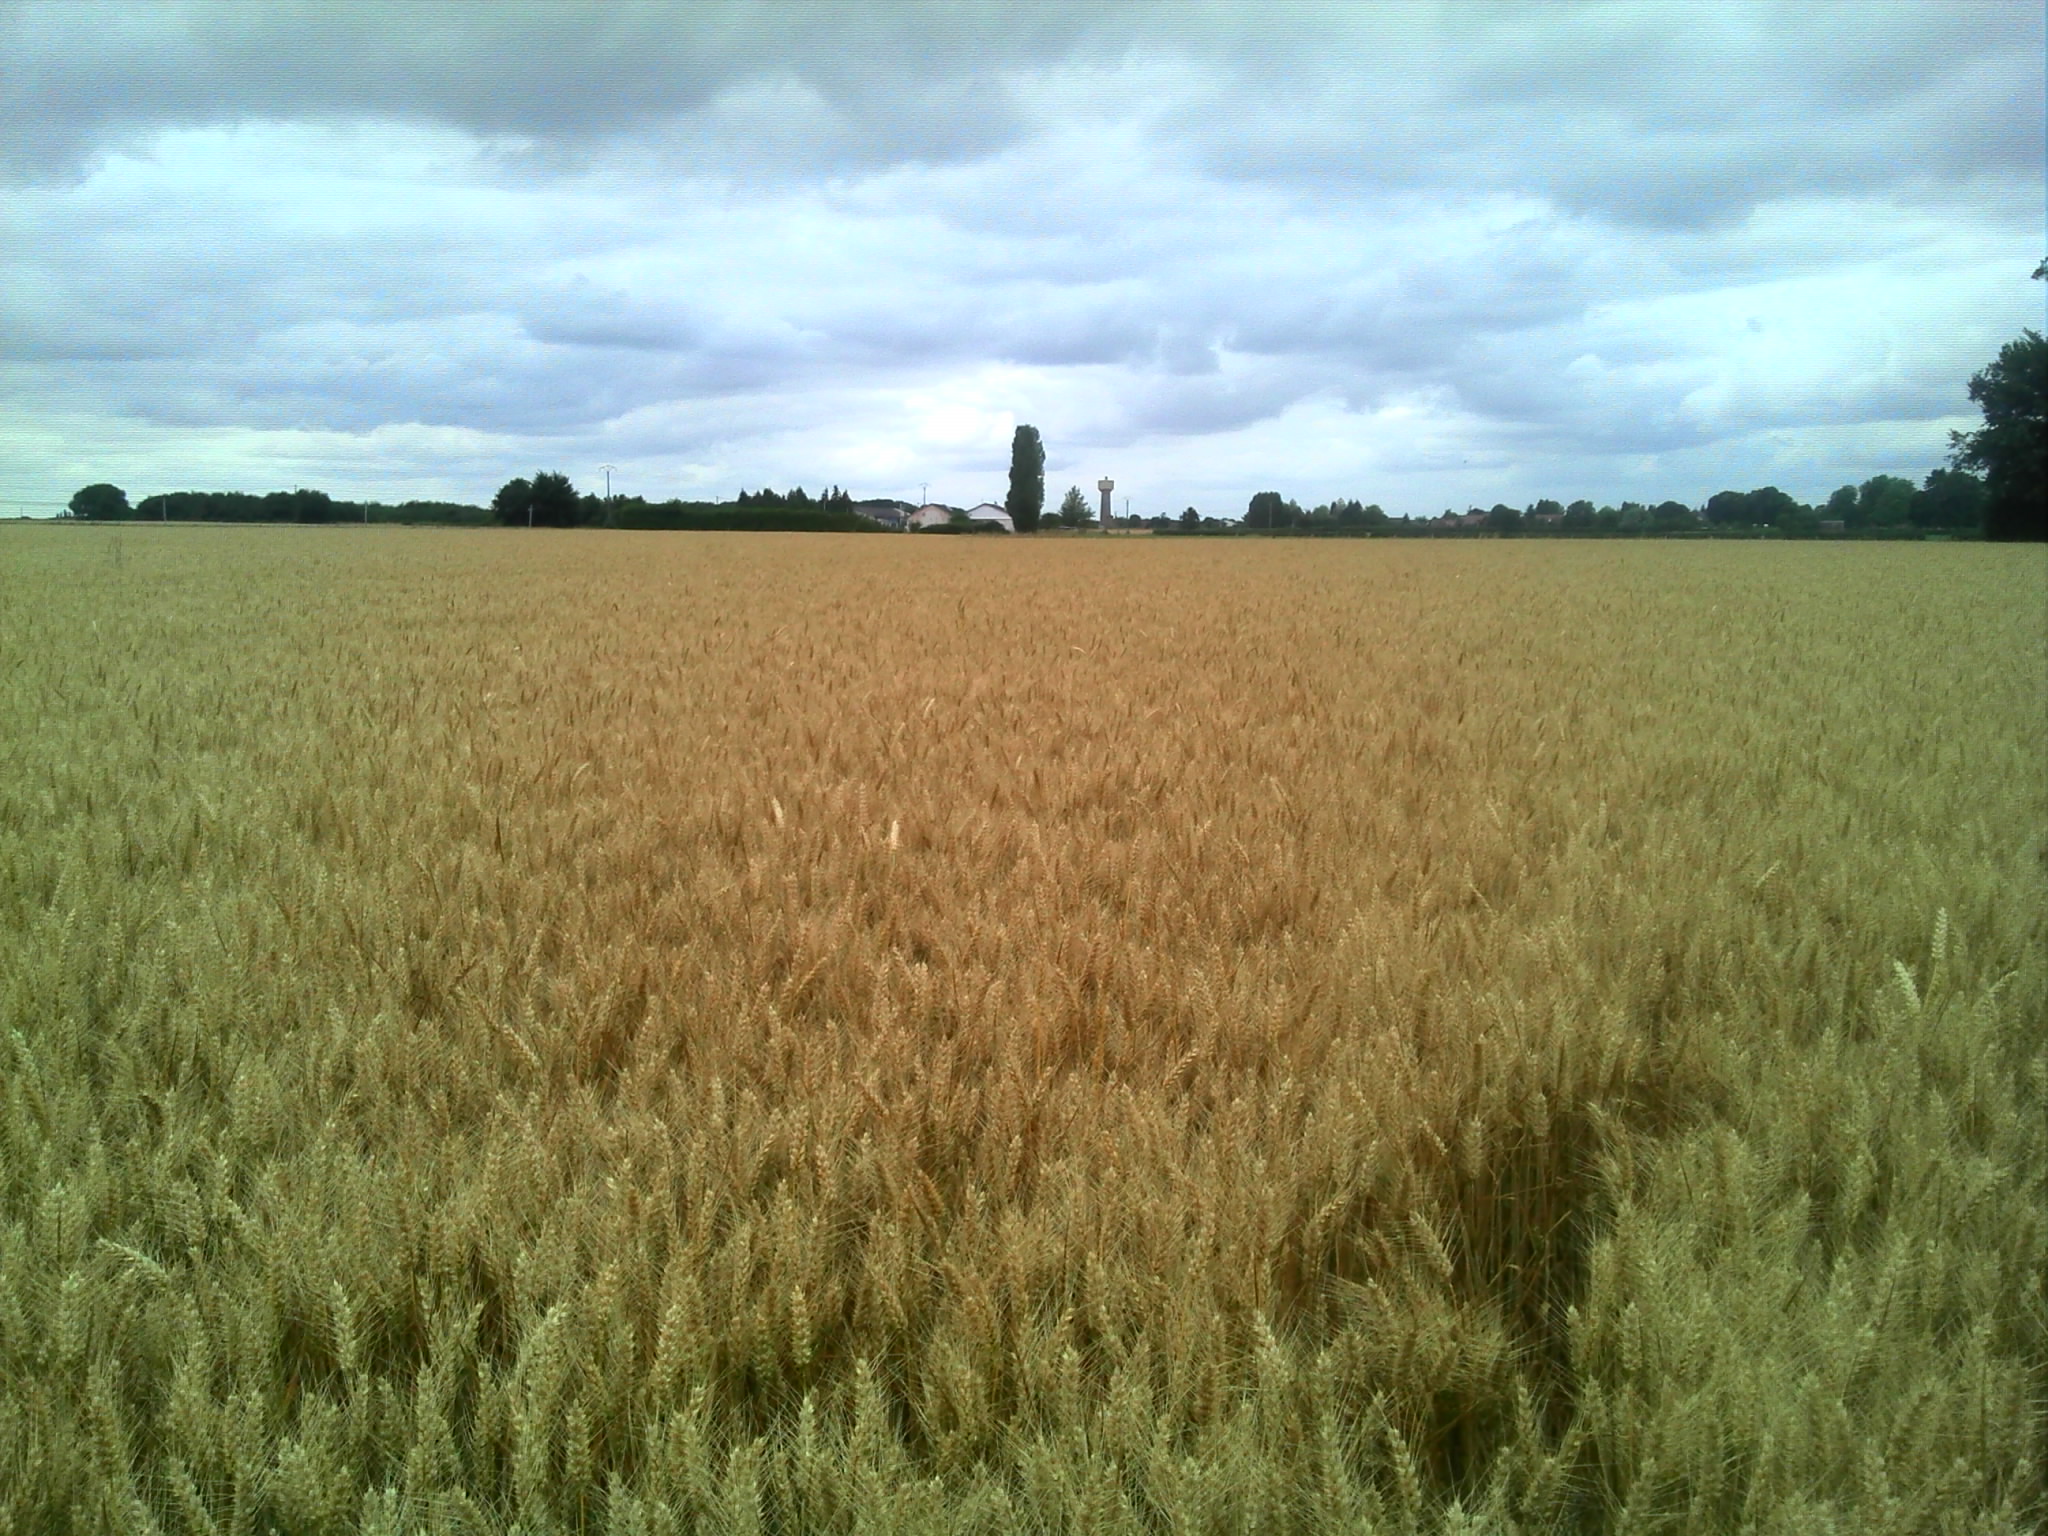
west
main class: Cropland
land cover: Common wheat
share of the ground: > 75 %
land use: Agriculture (excluding fallow land and kitchen gardens)
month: July
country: FR
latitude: 49.0085
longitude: 0.7206
